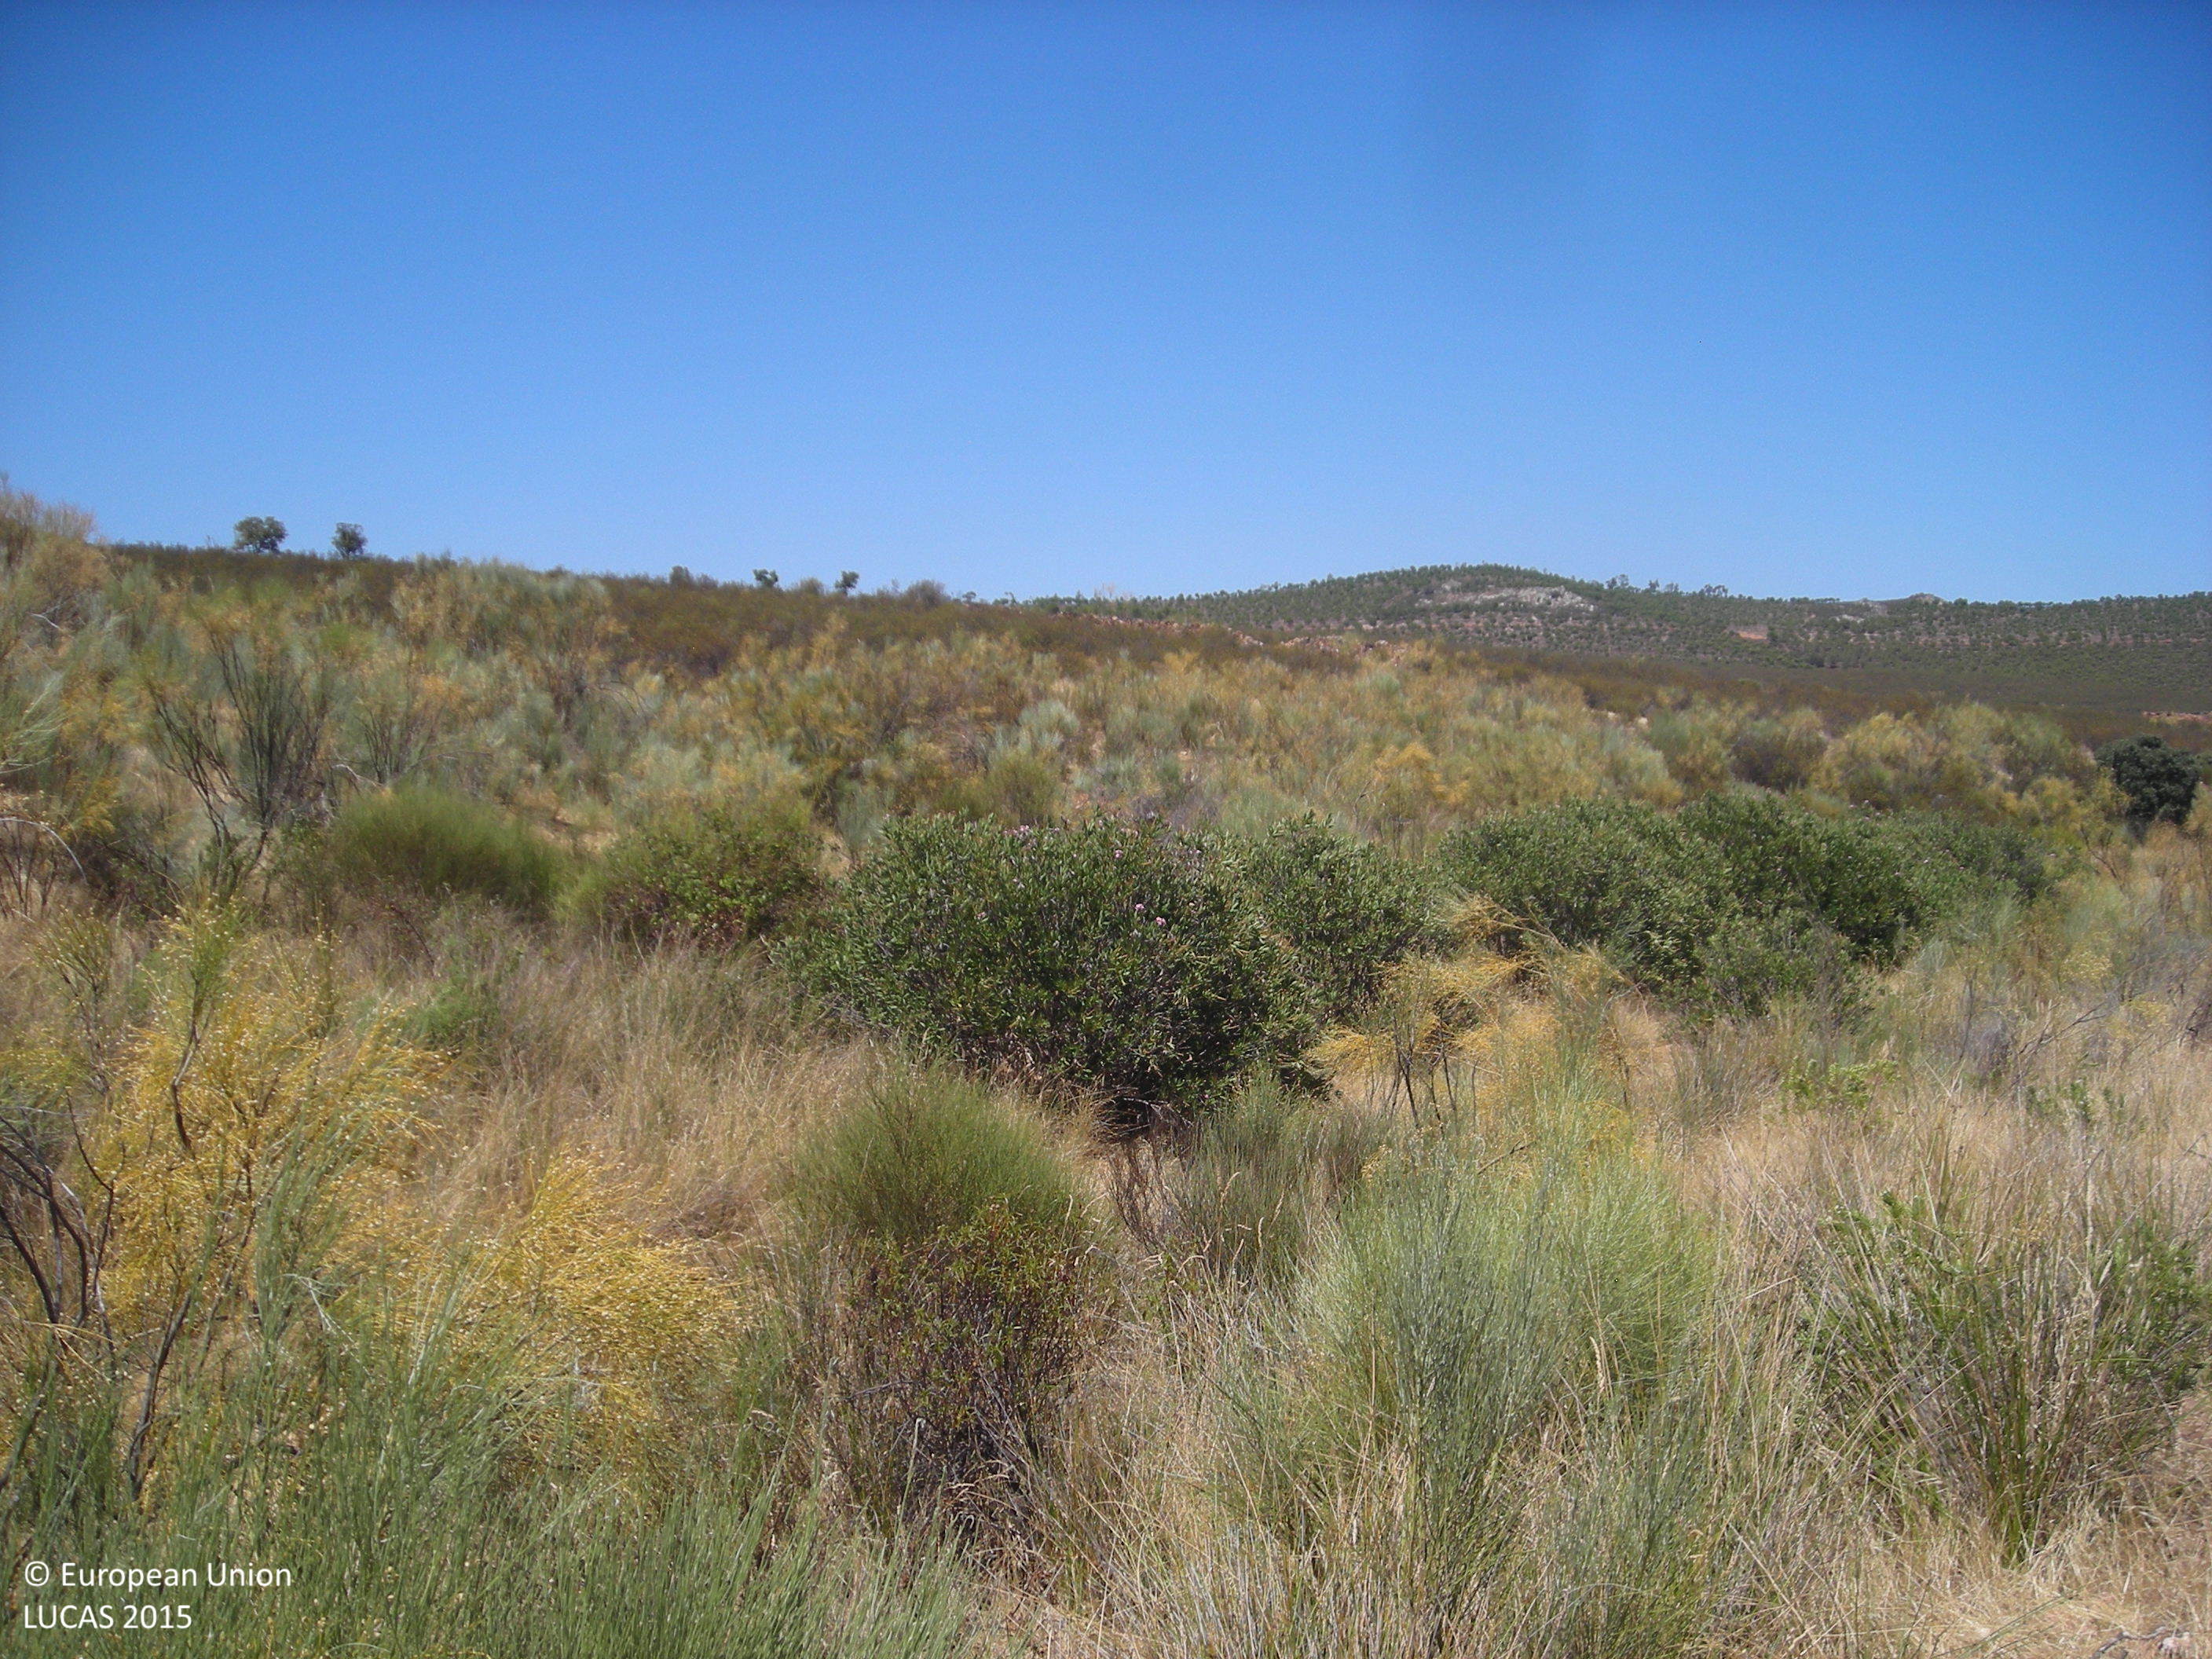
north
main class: Shrubland
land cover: Shrubland without tree cover
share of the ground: > 75 %
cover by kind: shrubs 100 %
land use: Semi-natural and natural areas not in use
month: July
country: ES
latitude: 38.7788
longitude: -5.7803
